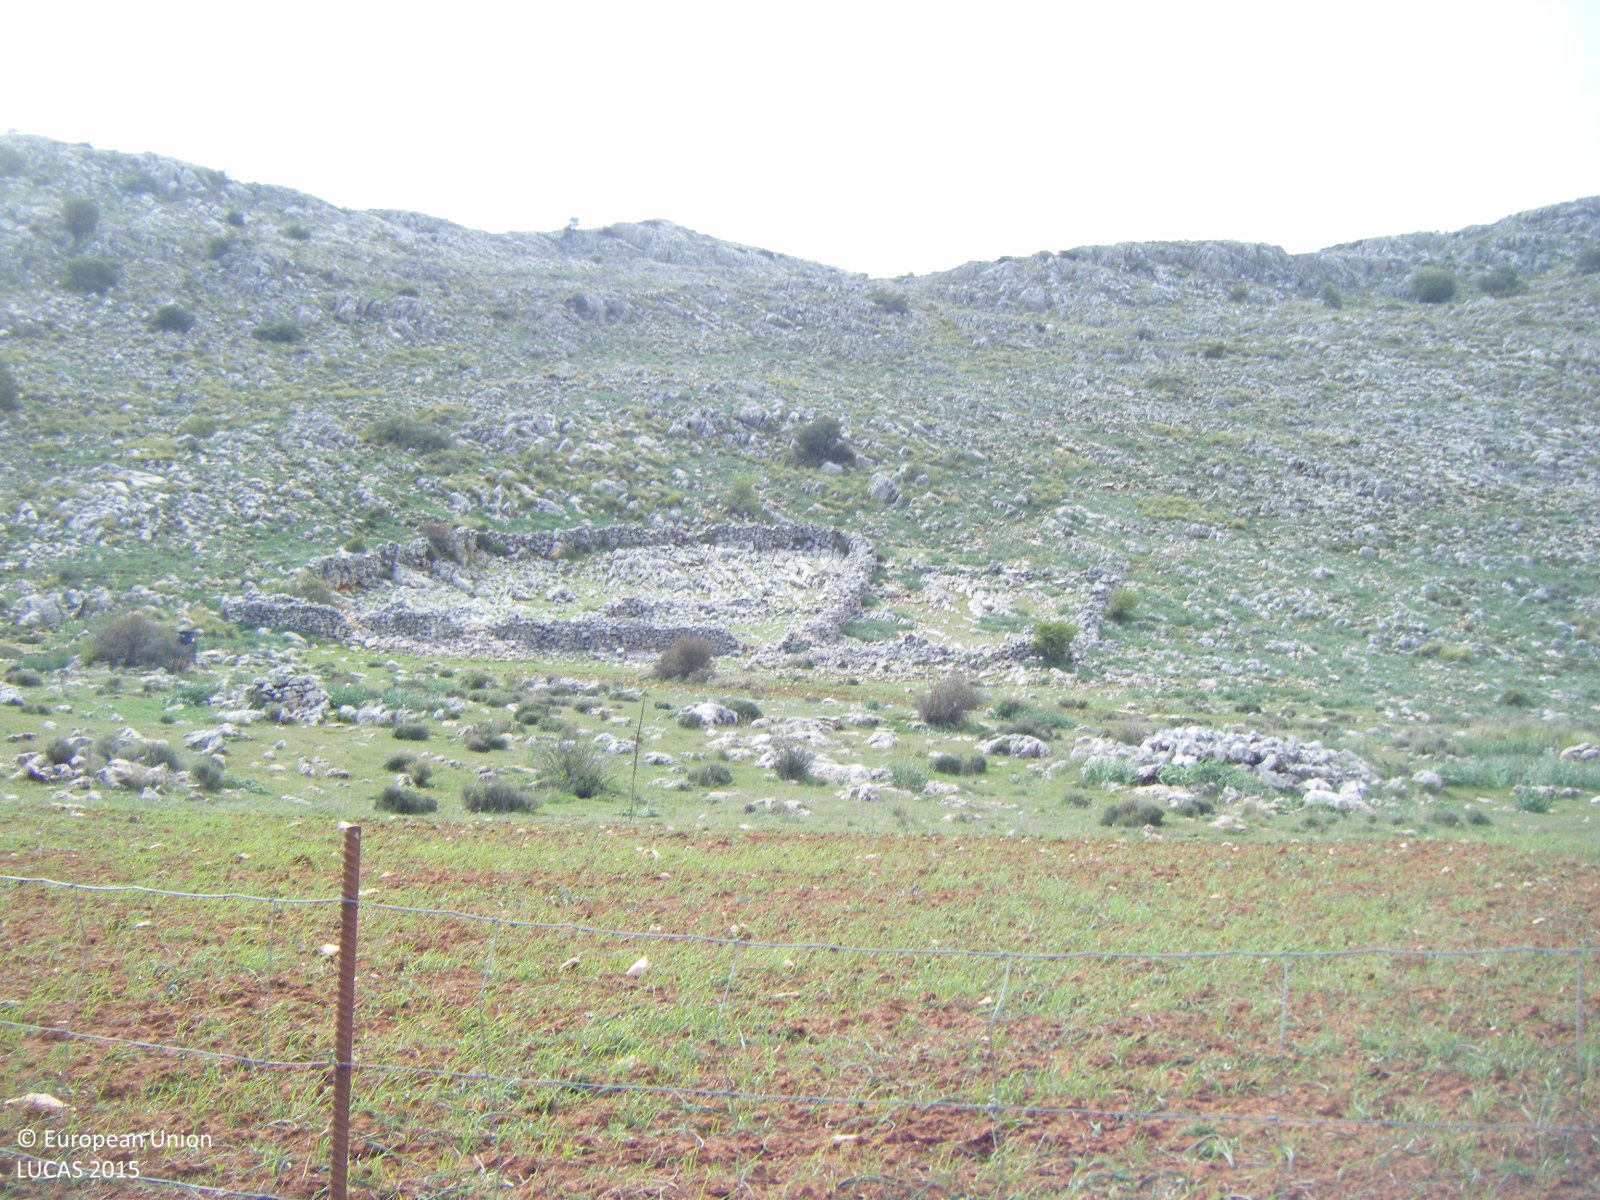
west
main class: Grassland
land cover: Grassland without tree/shrub cover
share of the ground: 50 - 75 %
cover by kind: herbaceous plants 50 %, consolidated bare surface 50 %
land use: Agriculture (excluding fallow land and kitchen gardens)
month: April
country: ES
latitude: 37.0903
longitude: -4.1348
